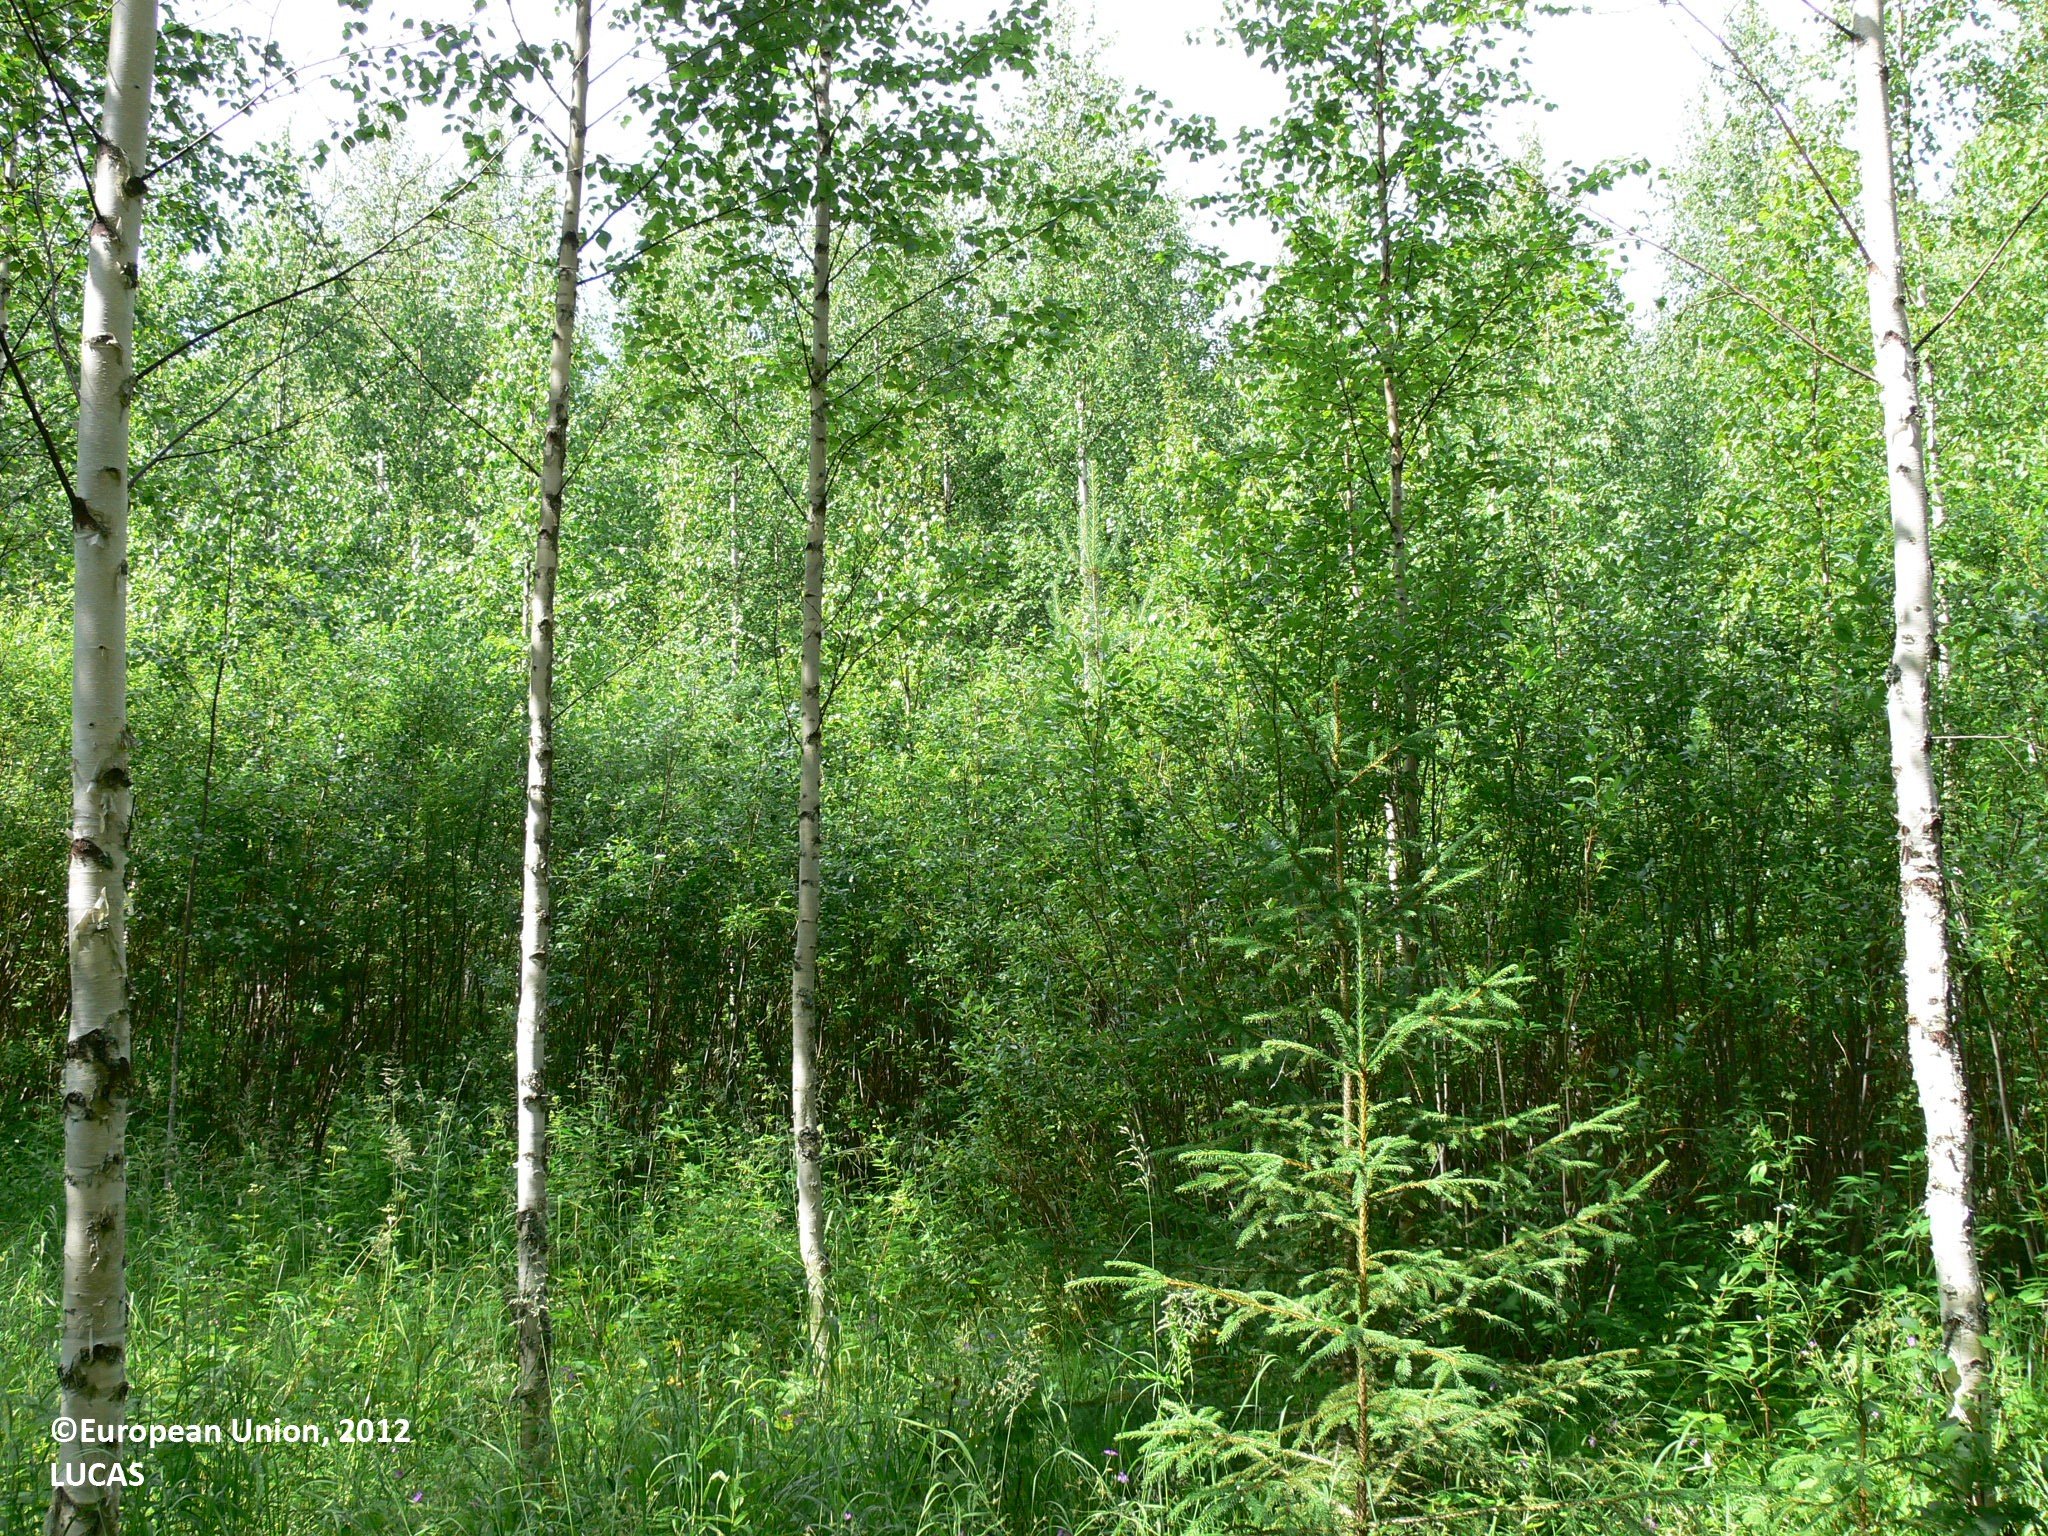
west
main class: Woodland
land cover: Broadleaved woodland
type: boreal forest
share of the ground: > 75 %
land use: Forestry
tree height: > 5 m
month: July
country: FI
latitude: 63.1967
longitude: 29.9897
